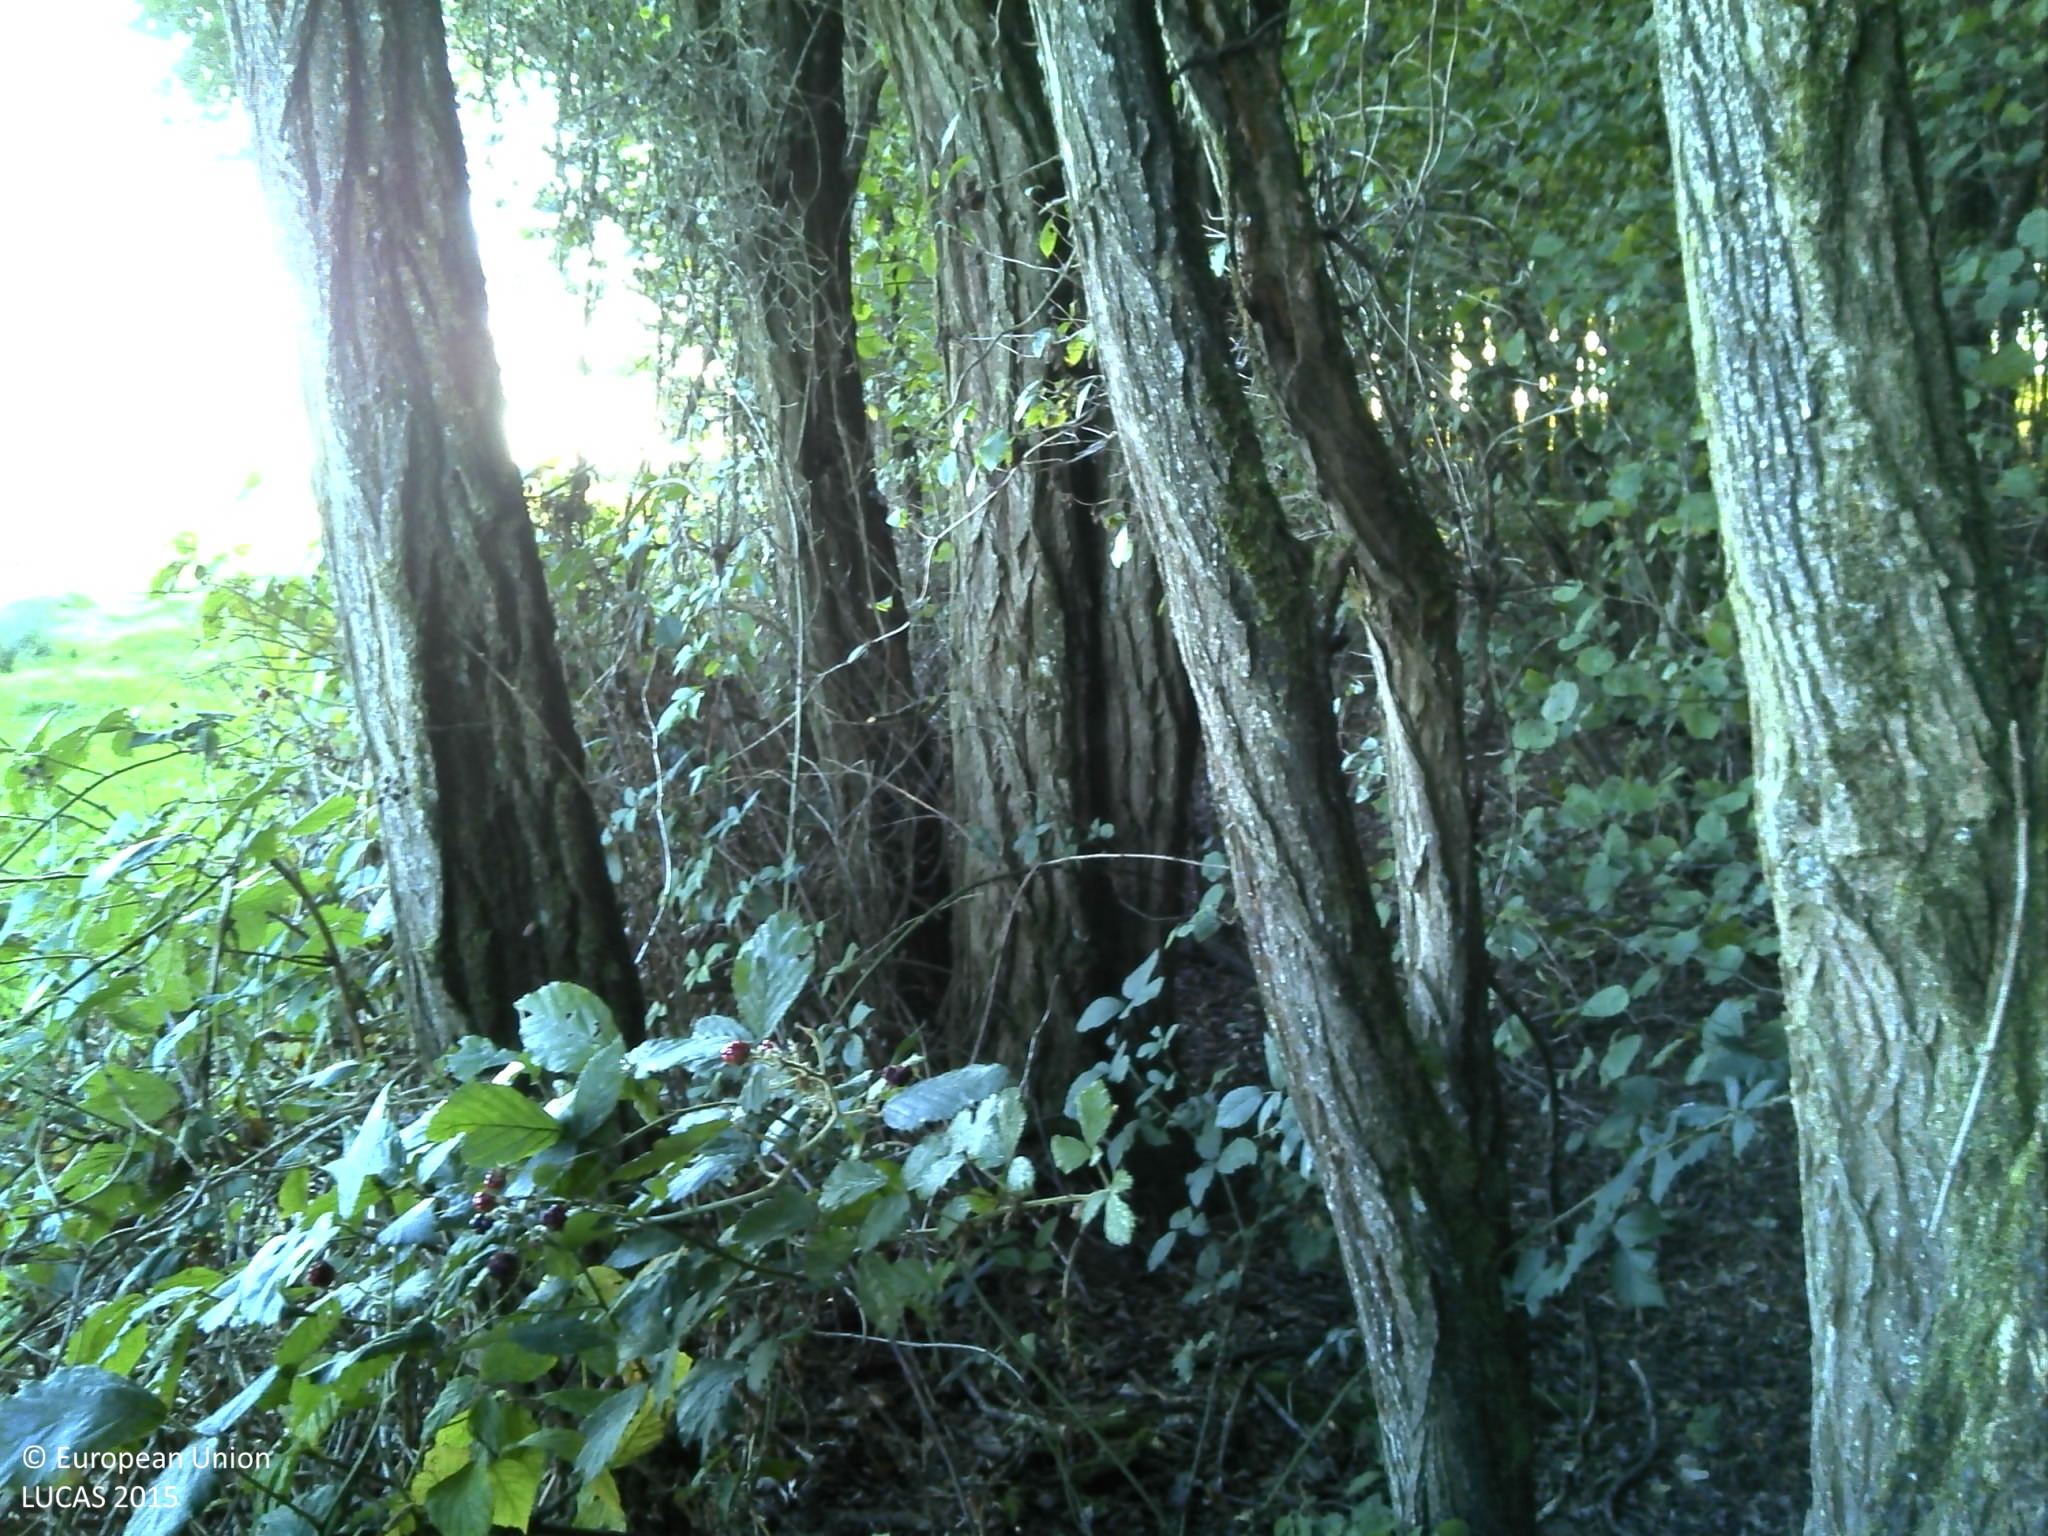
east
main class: Grassland
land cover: Grassland without tree/shrub cover
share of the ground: > 75 %
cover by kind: herbaceous plants 100 %
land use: Agriculture (excluding fallow land and kitchen gardens)
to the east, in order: Grassland without tree/shrub cover; Fences; Managed hedges; Spontaneously vegetated surfaces
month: September
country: FR
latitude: 47.0006
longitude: 4.4370
